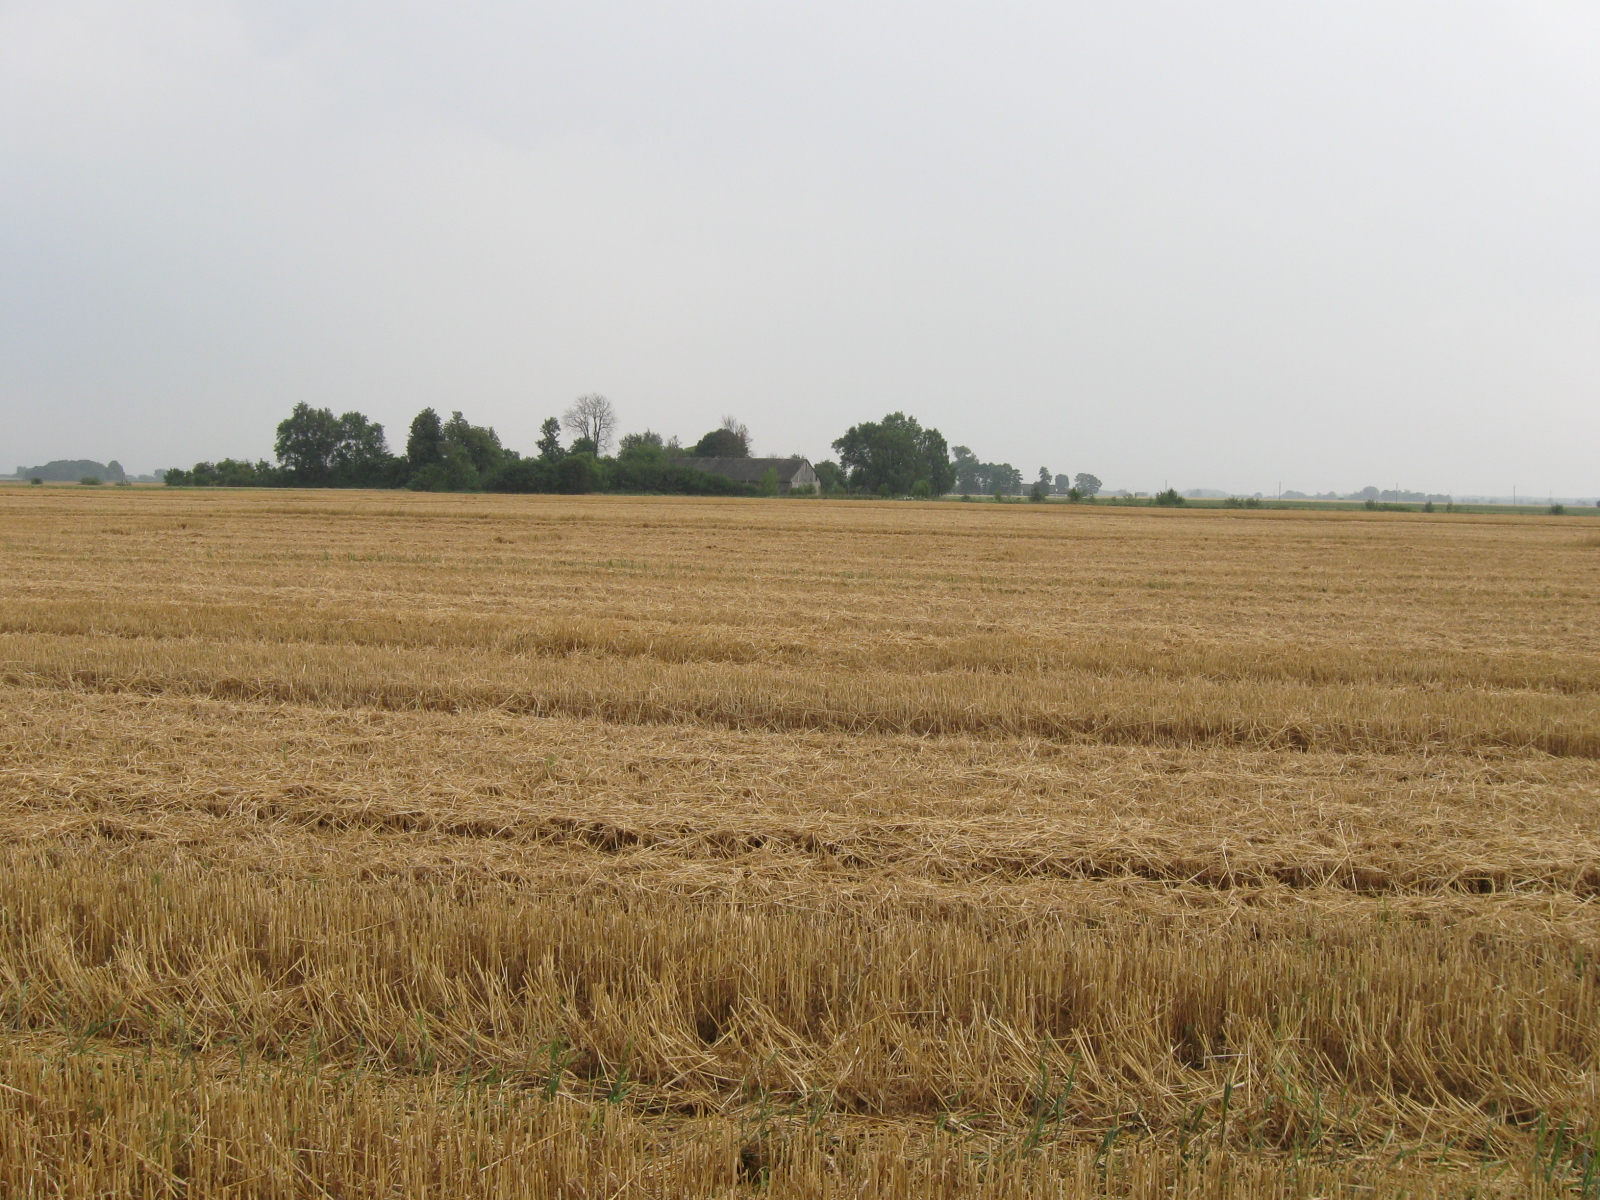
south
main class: Cropland
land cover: Common wheat
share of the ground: > 75 %
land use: Agriculture (excluding fallow land and kitchen gardens)
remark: Harvested field
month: August
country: LT
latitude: 54.6741
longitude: 23.4321
